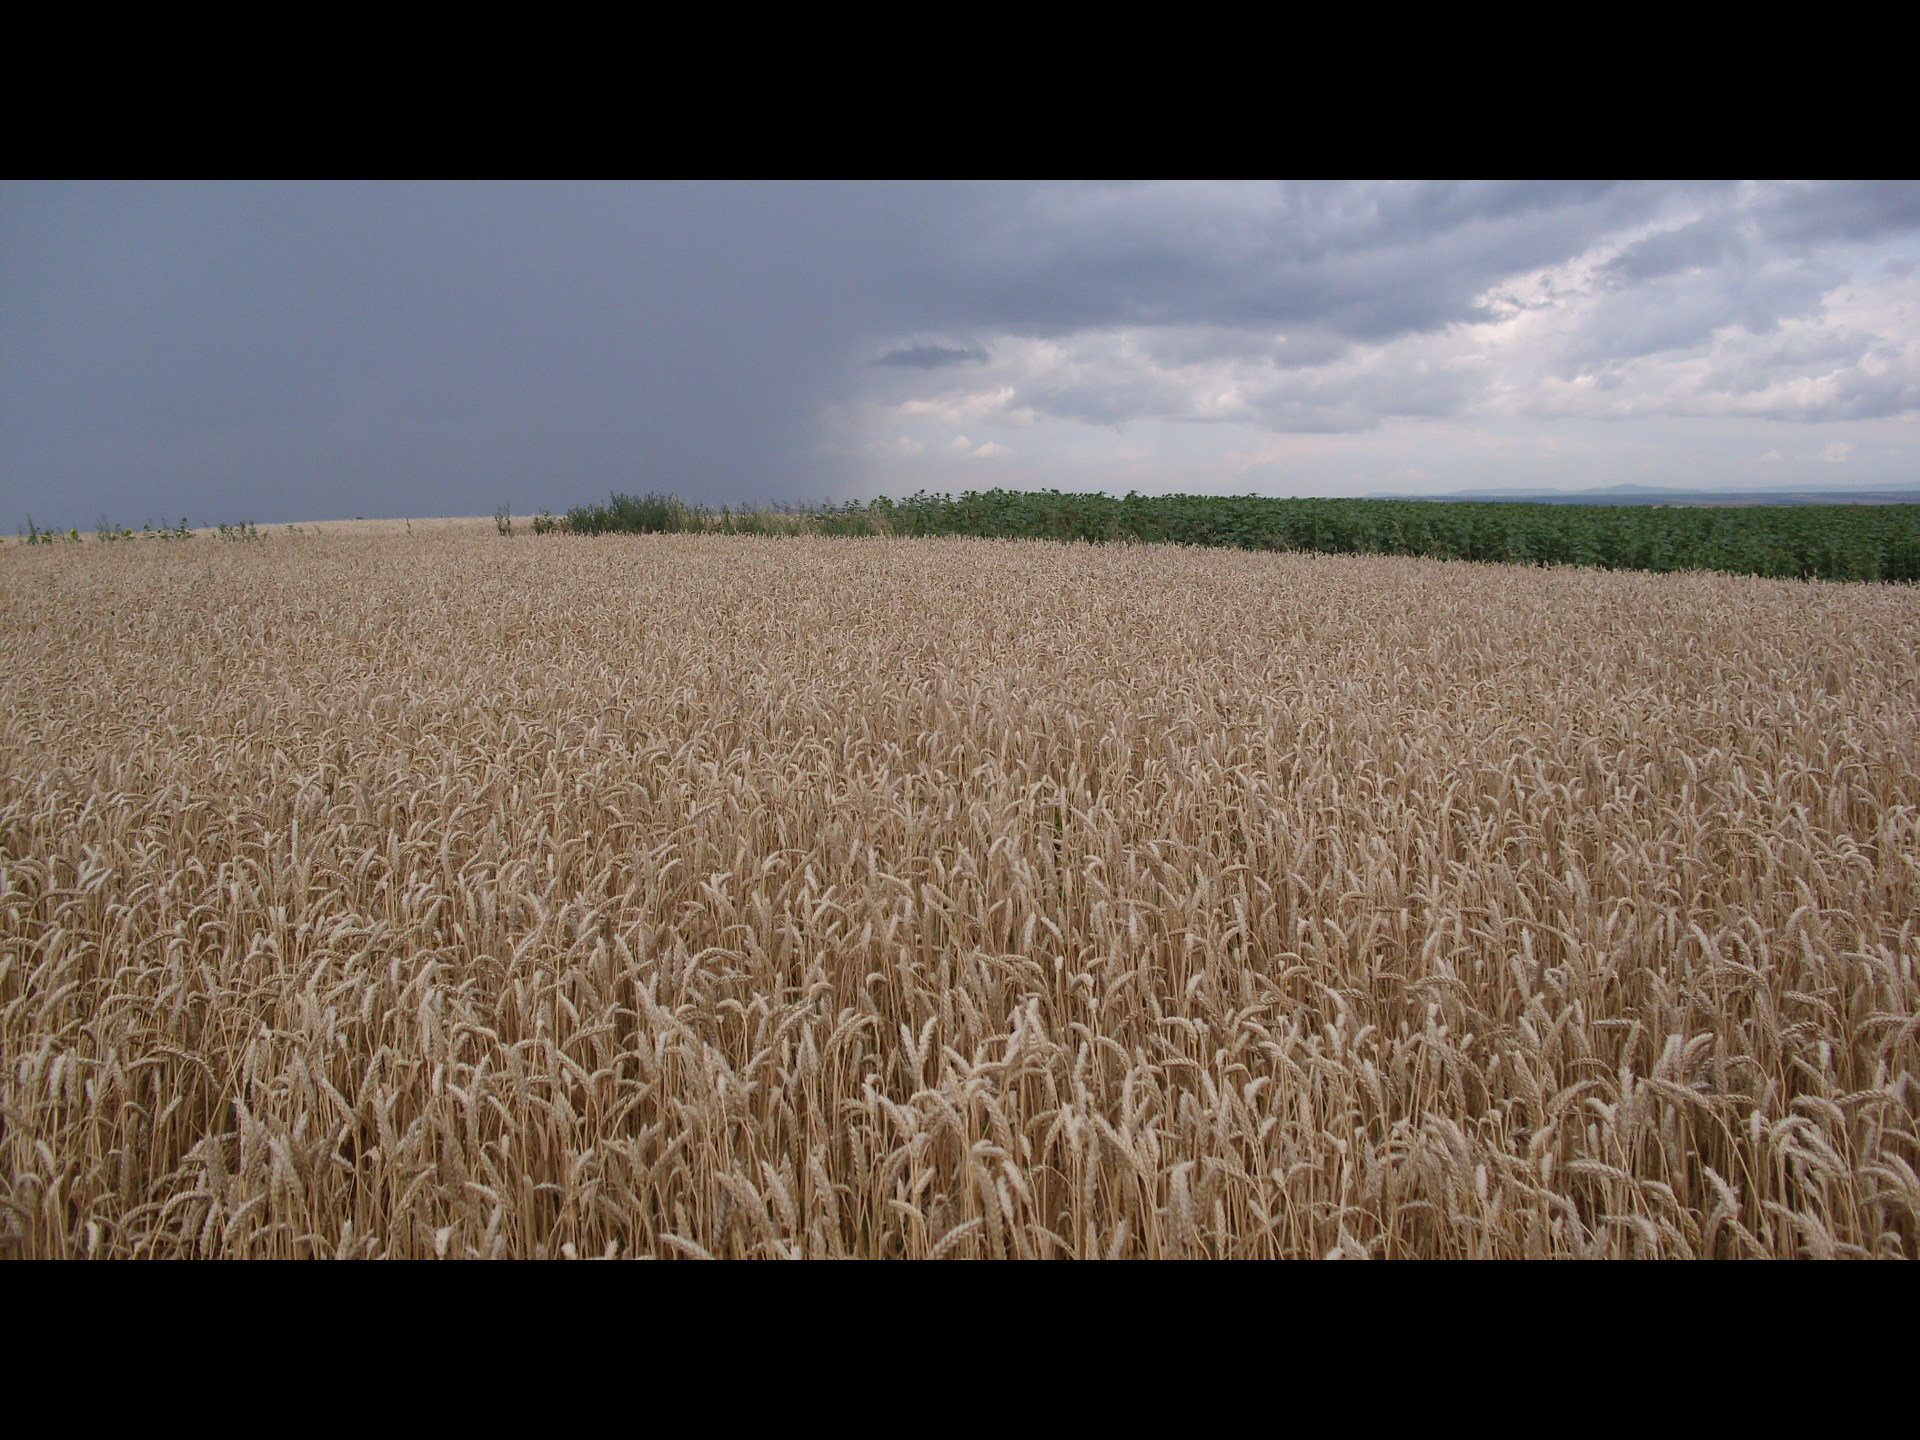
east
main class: Cropland
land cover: Common wheat
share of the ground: > 75 %
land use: Agriculture (excluding fallow land and kitchen gardens)
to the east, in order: Common wheat; Grass margins; Common wheat; Grass margins; Common wheat
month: June
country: BG
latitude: 43.5936
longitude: 23.4847
